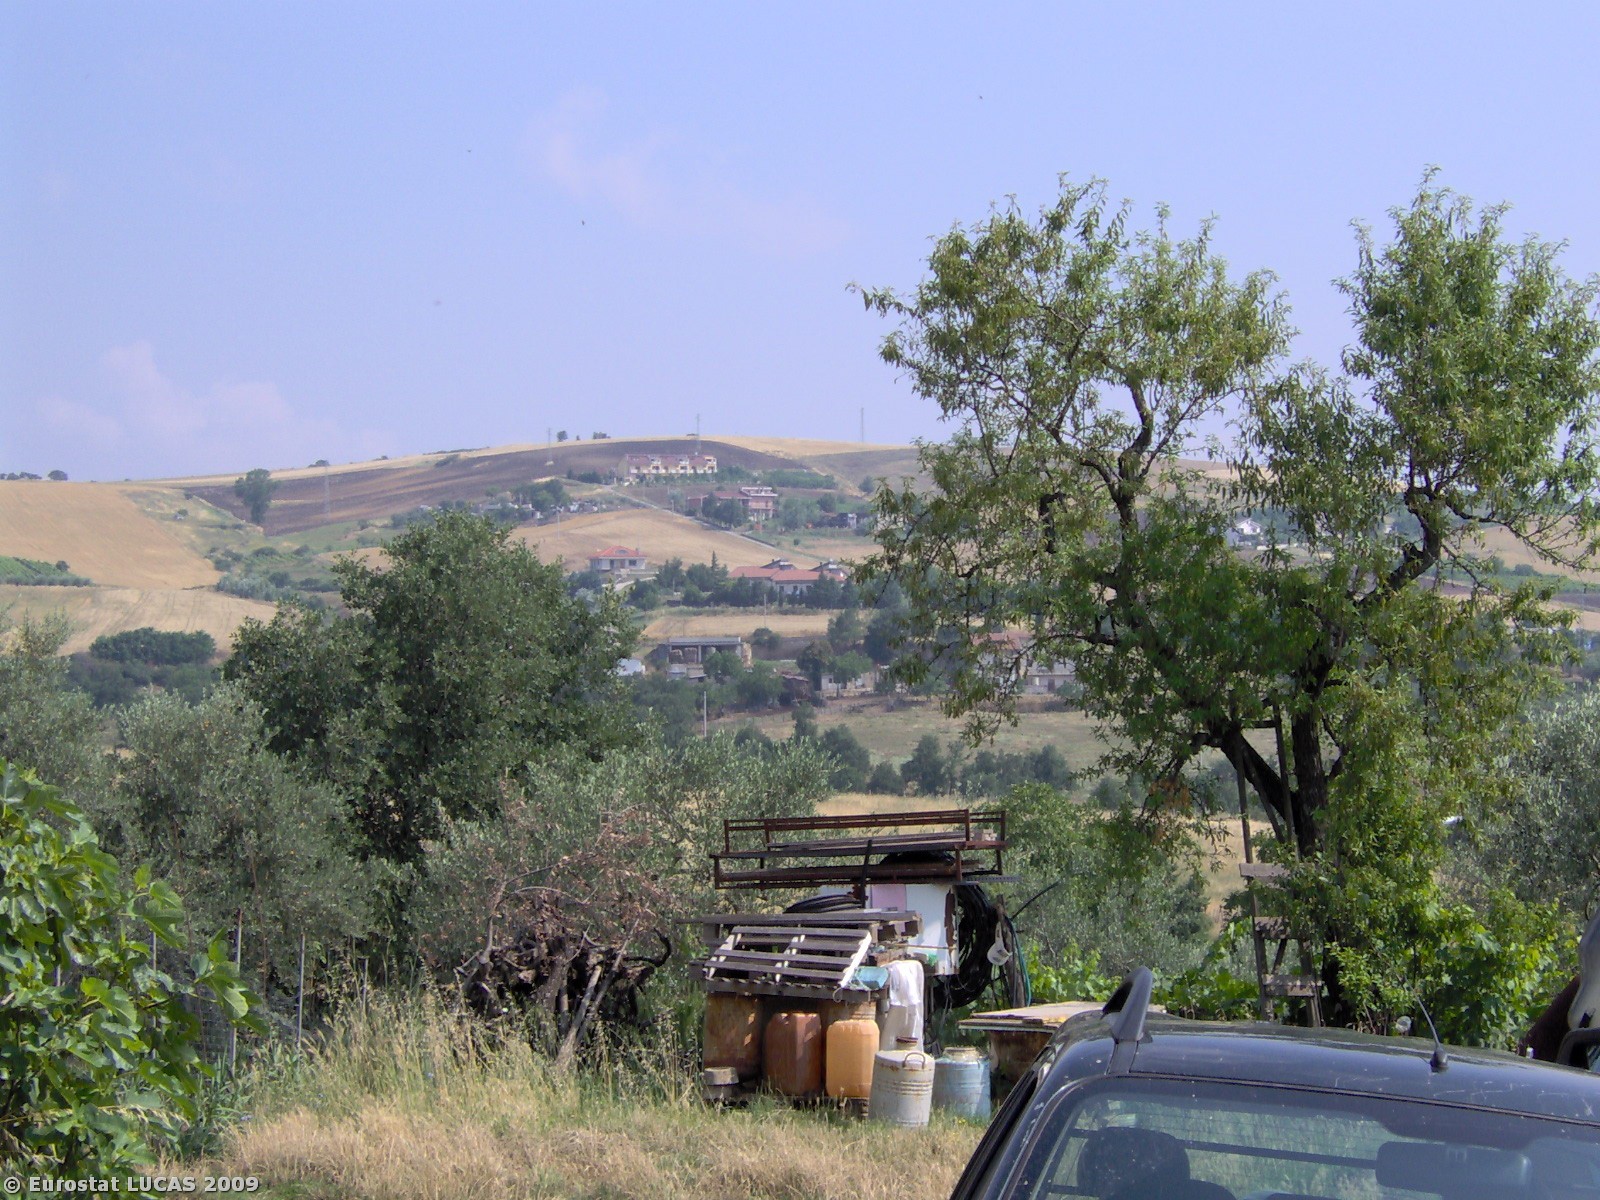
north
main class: Cropland
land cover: Olive groves
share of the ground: 50 - 75 %
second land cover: Bare land
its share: > 75 %
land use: Agriculture (excluding fallow land and kitchen gardens)
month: July
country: IT
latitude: 40.9956
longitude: 15.6026
